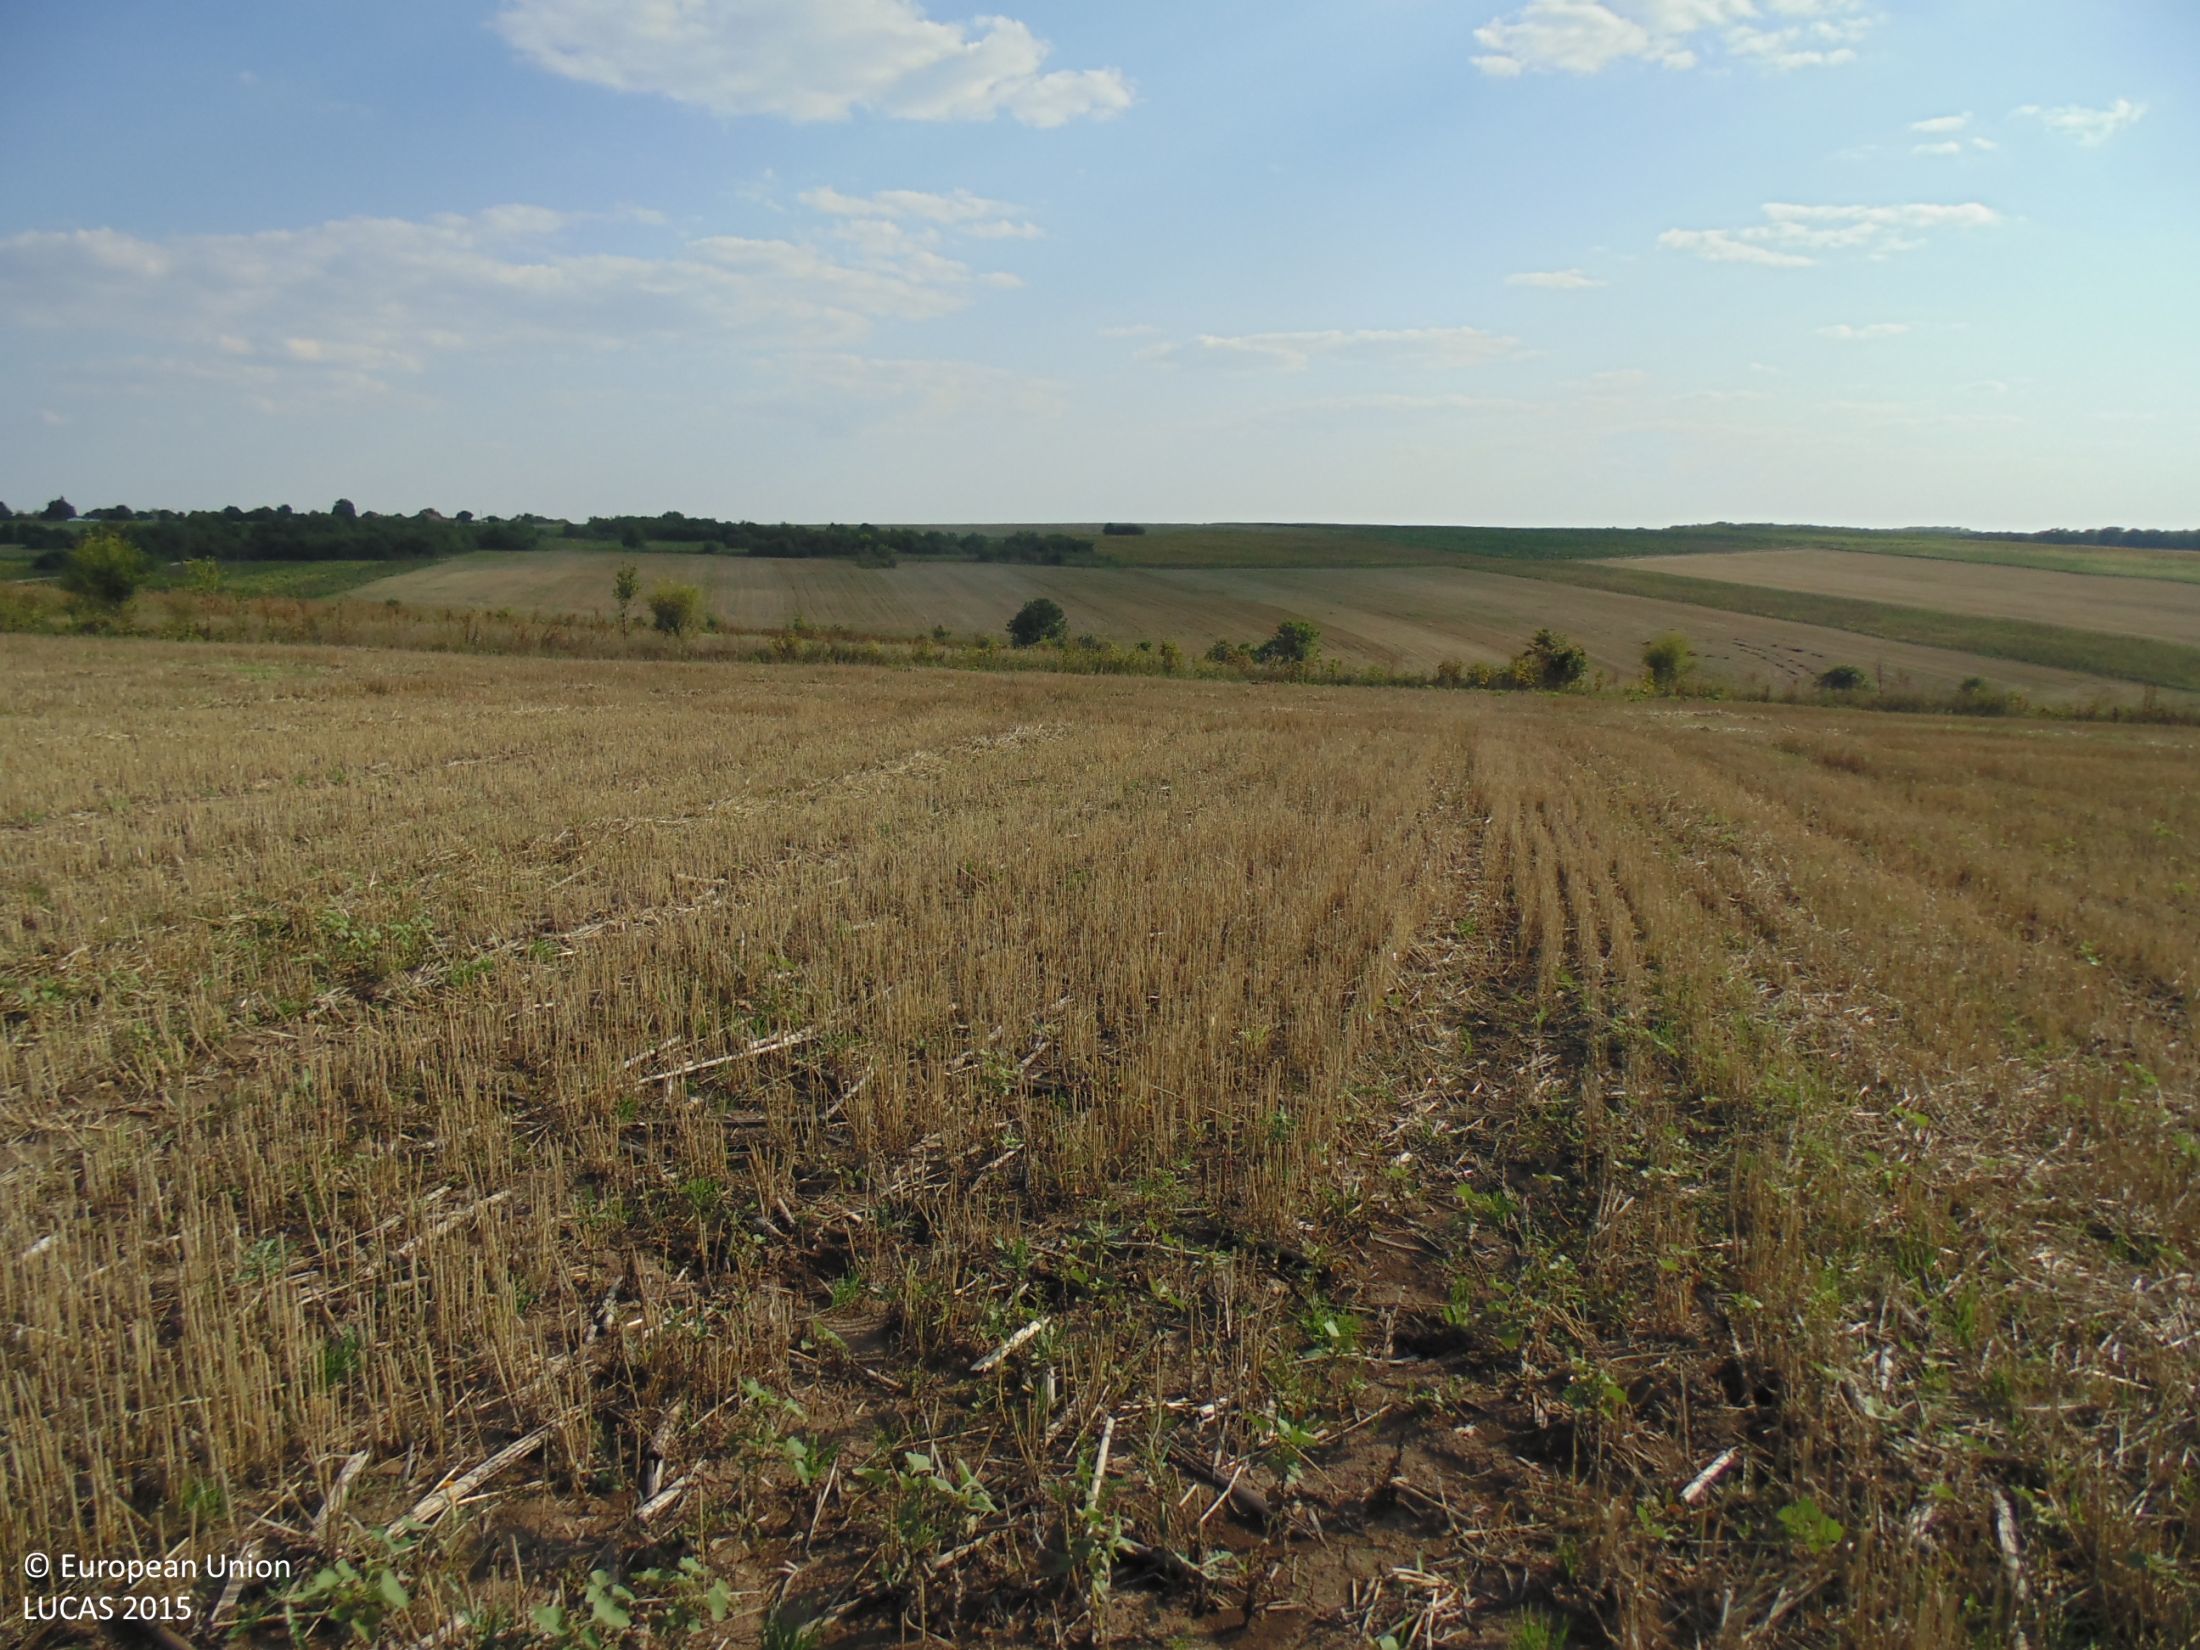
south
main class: Cropland
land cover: Common wheat
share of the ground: 50 - 75 %
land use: Agriculture (excluding fallow land and kitchen gardens)
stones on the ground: < 10 %
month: August
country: BG
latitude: 43.7396
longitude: 27.2496
